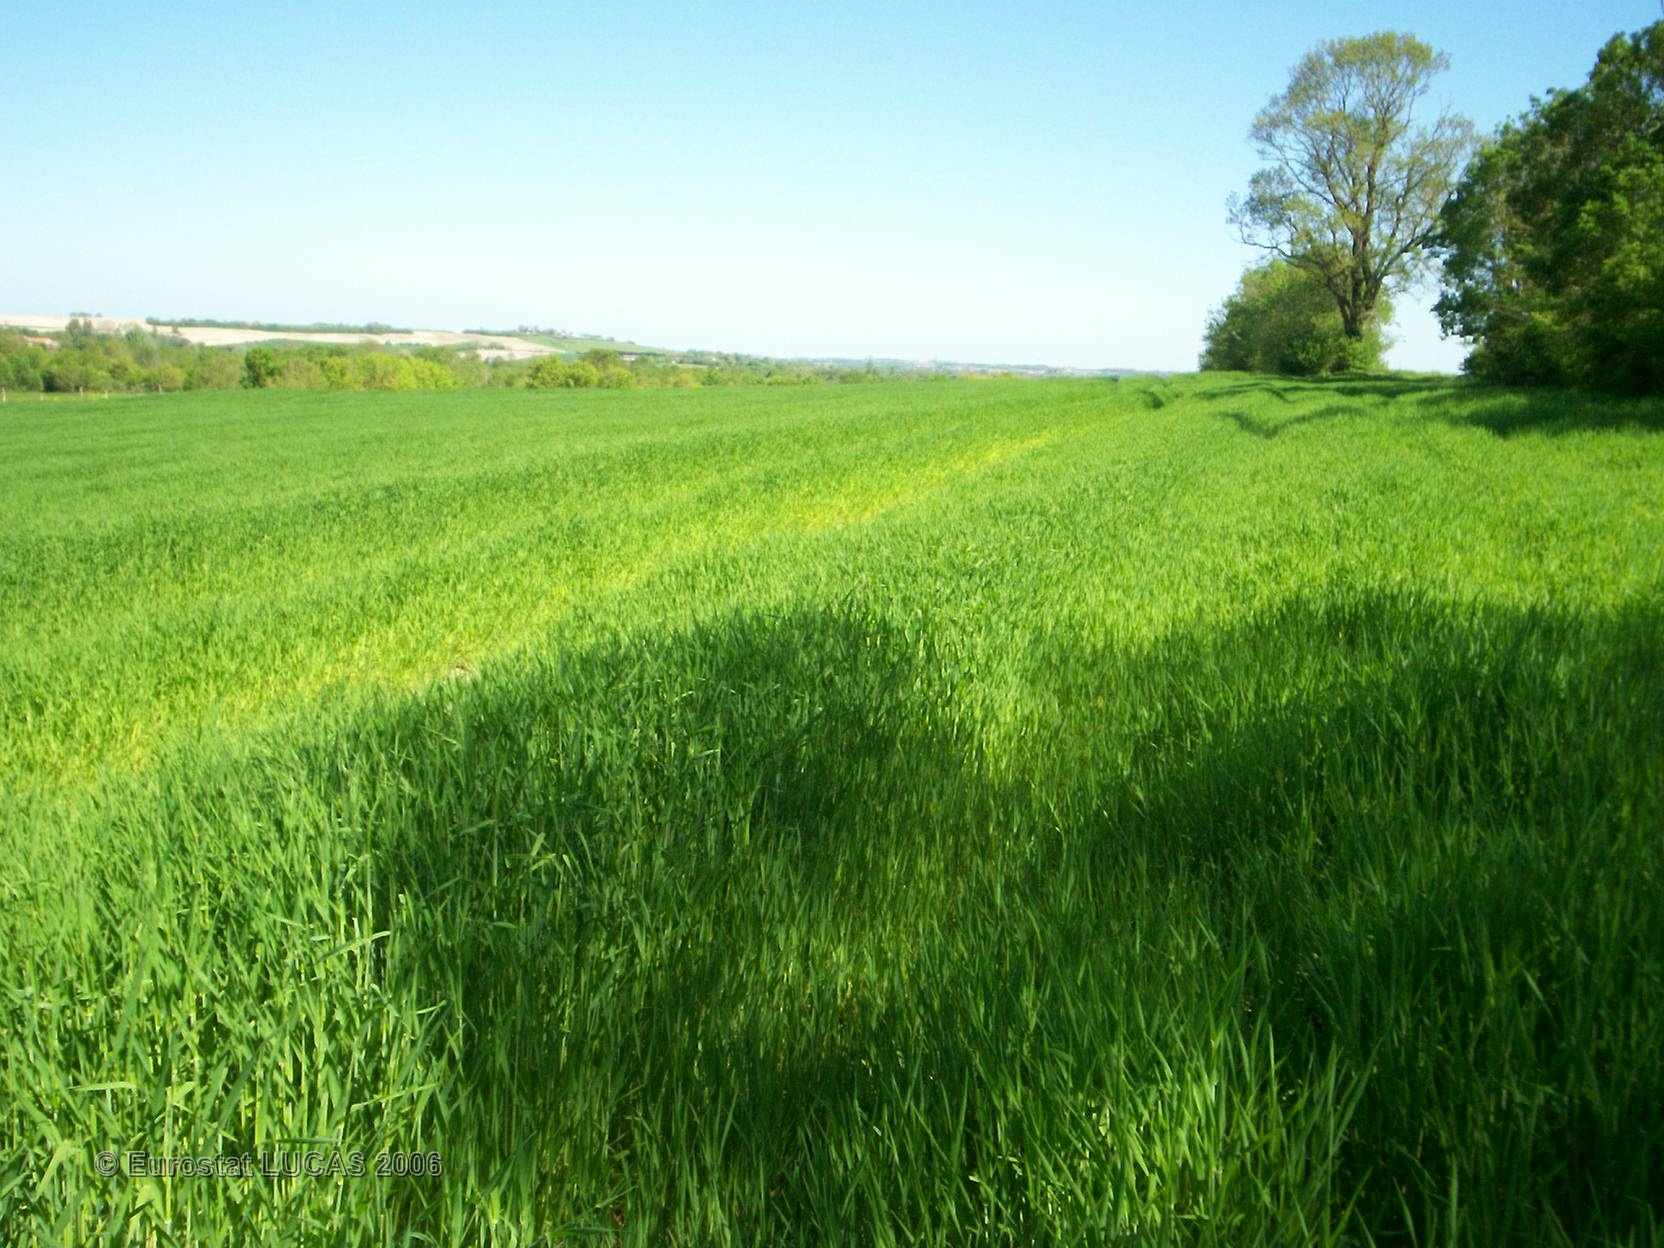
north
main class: Cropland
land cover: Barley
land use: Agriculture (excluding fallow land and kitchen gardens)
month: April
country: FR
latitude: 45.9967
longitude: -0.6780
